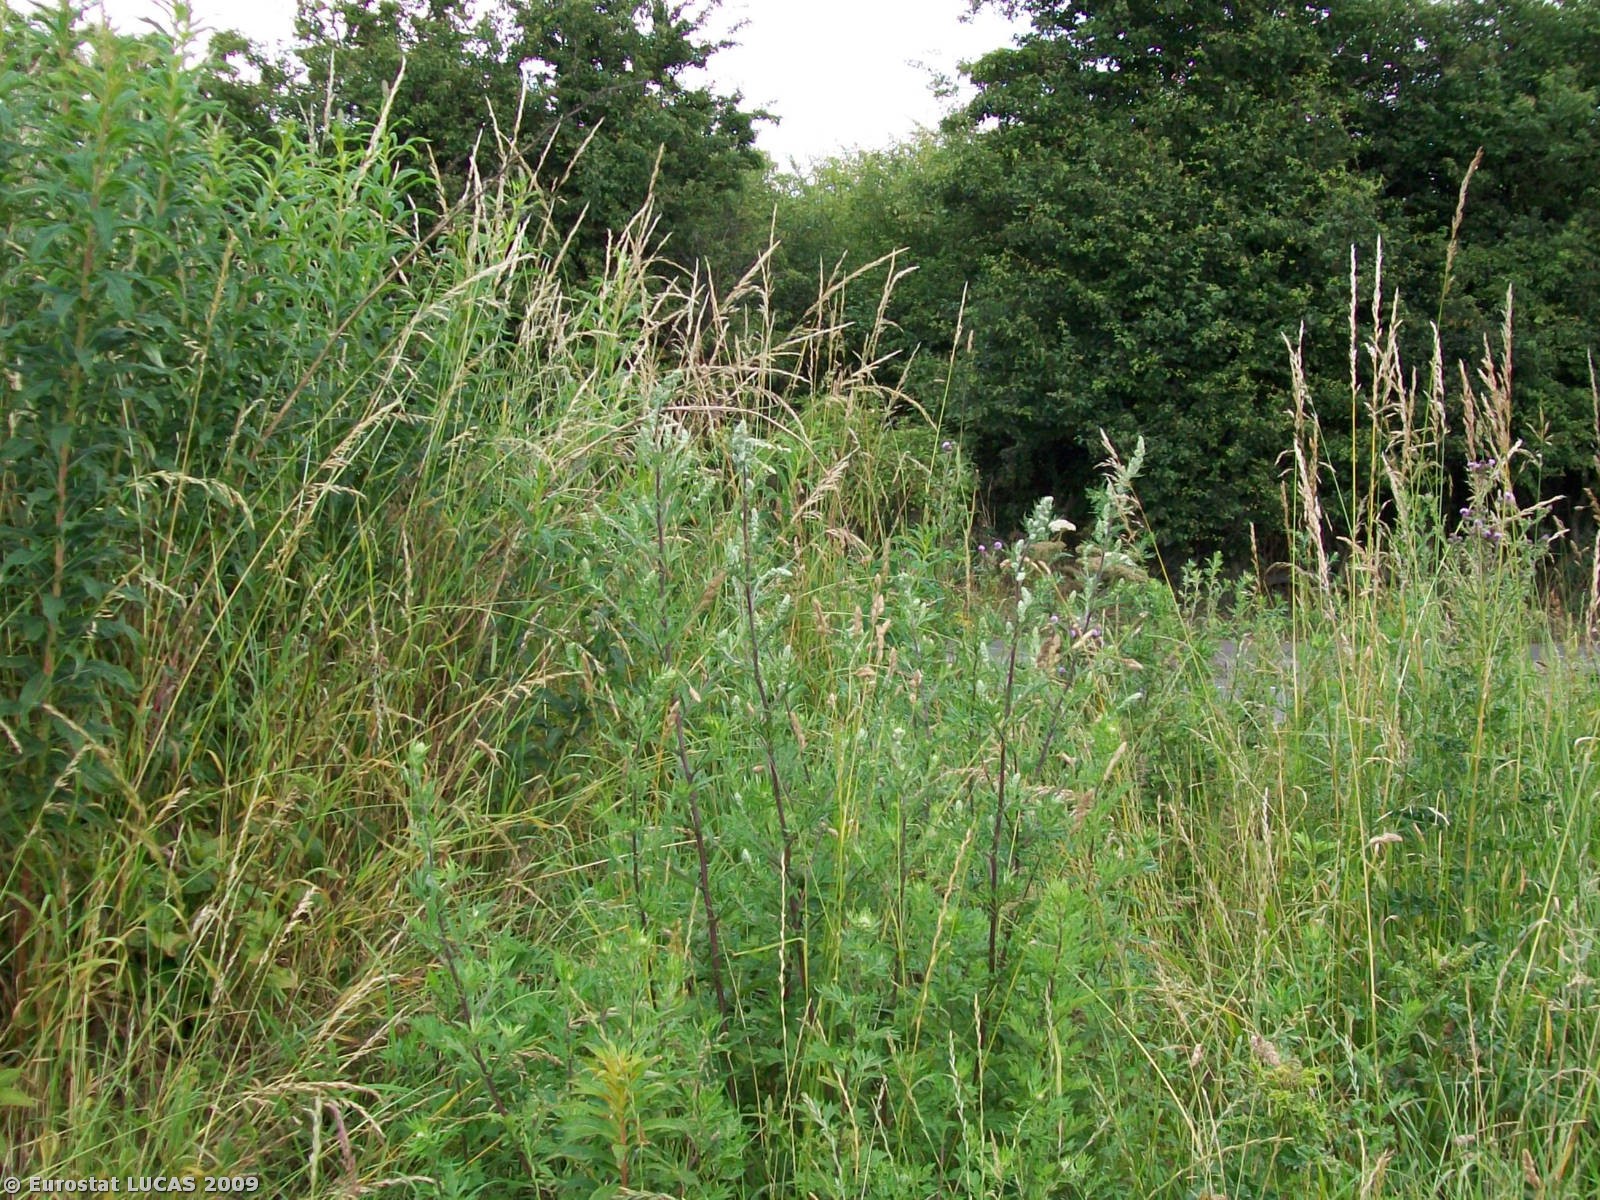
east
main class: Cropland
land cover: Barley
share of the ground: 10 - 25 %
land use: Agriculture (excluding fallow land and kitchen gardens)
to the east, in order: Barley; Electric lines; Grass margins; Managed hedges; Paved roads, cycling and walking lanes; Other structural elements; Managed hedges; Fences; Abandoned hedges; Grass margins; Ditches and canals; Grassland with sparse tree/shrub cover; Inland water bodies
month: July
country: GB
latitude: 53.7743
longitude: -1.3520
